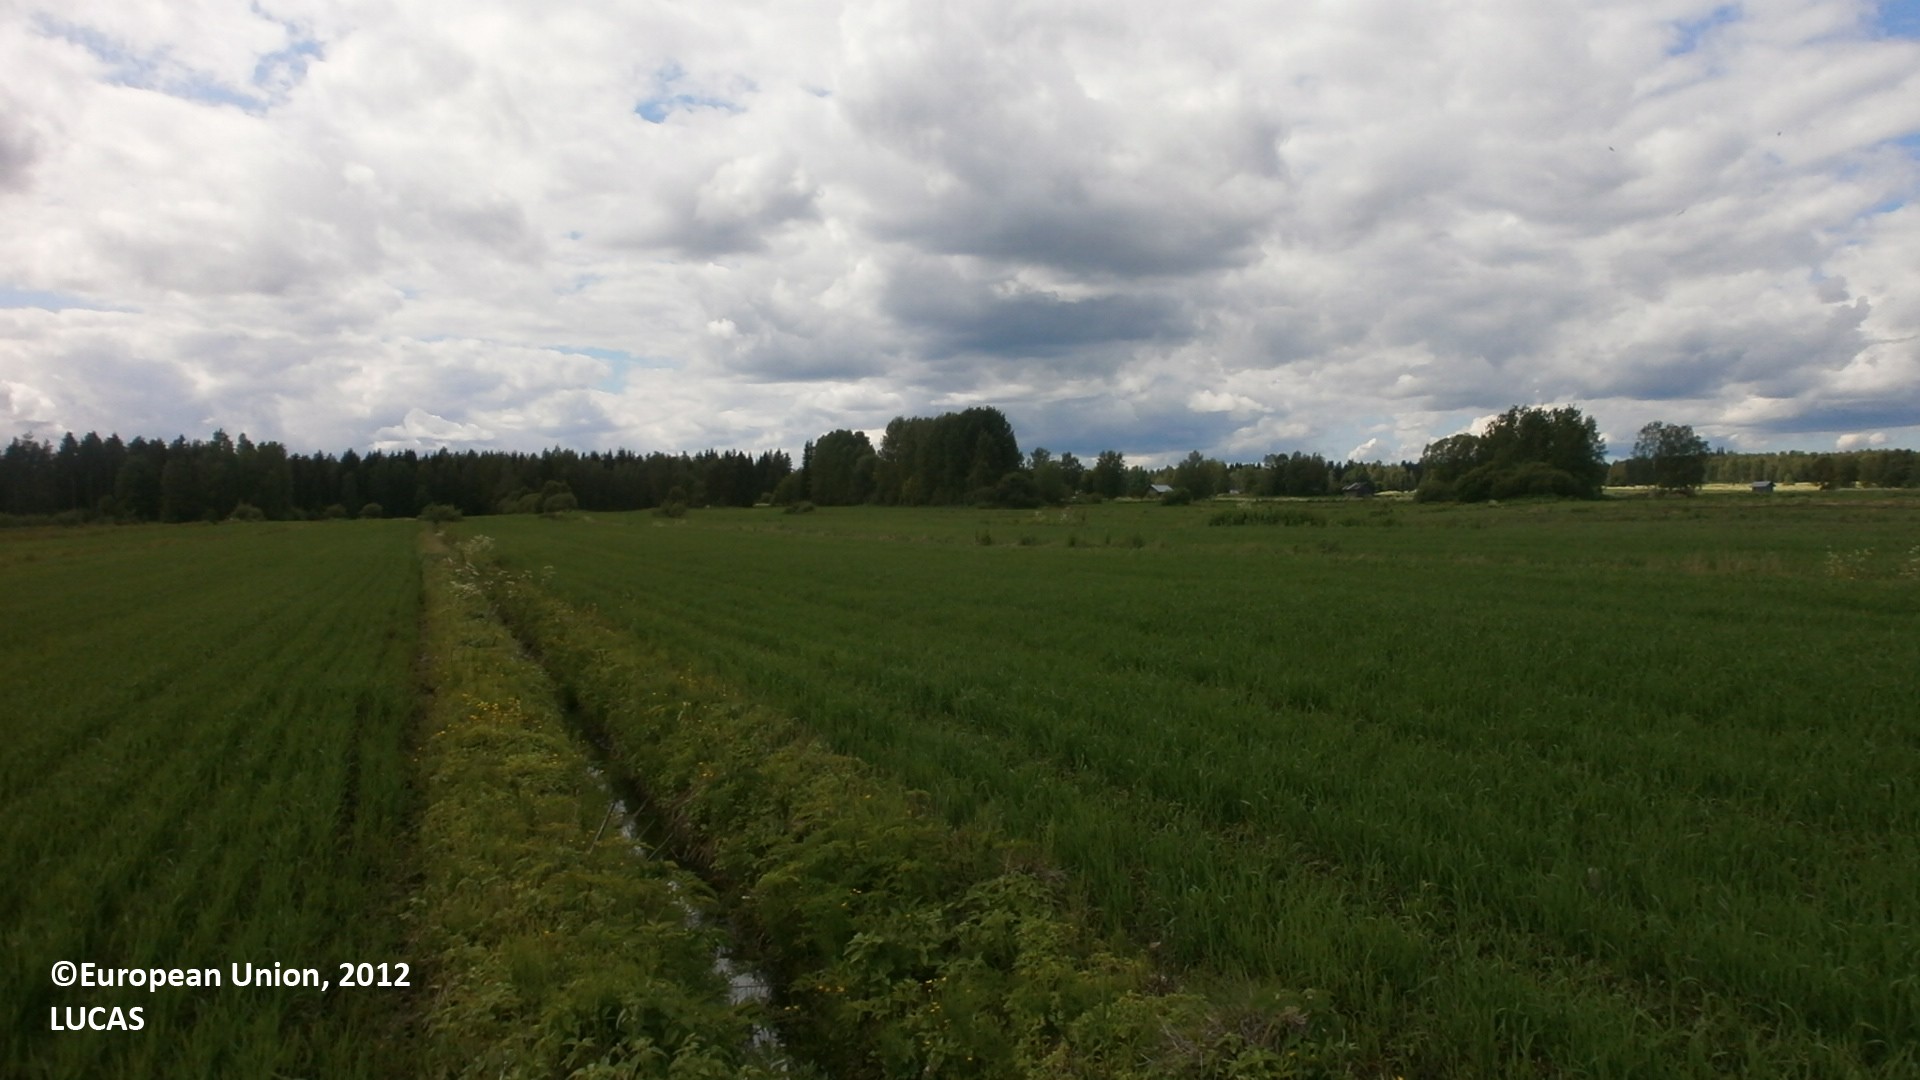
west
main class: Cropland
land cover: Oats
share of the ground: > 75 %
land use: Agriculture (excluding fallow land and kitchen gardens)
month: June
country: FI
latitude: 64.2770
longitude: 24.9278
